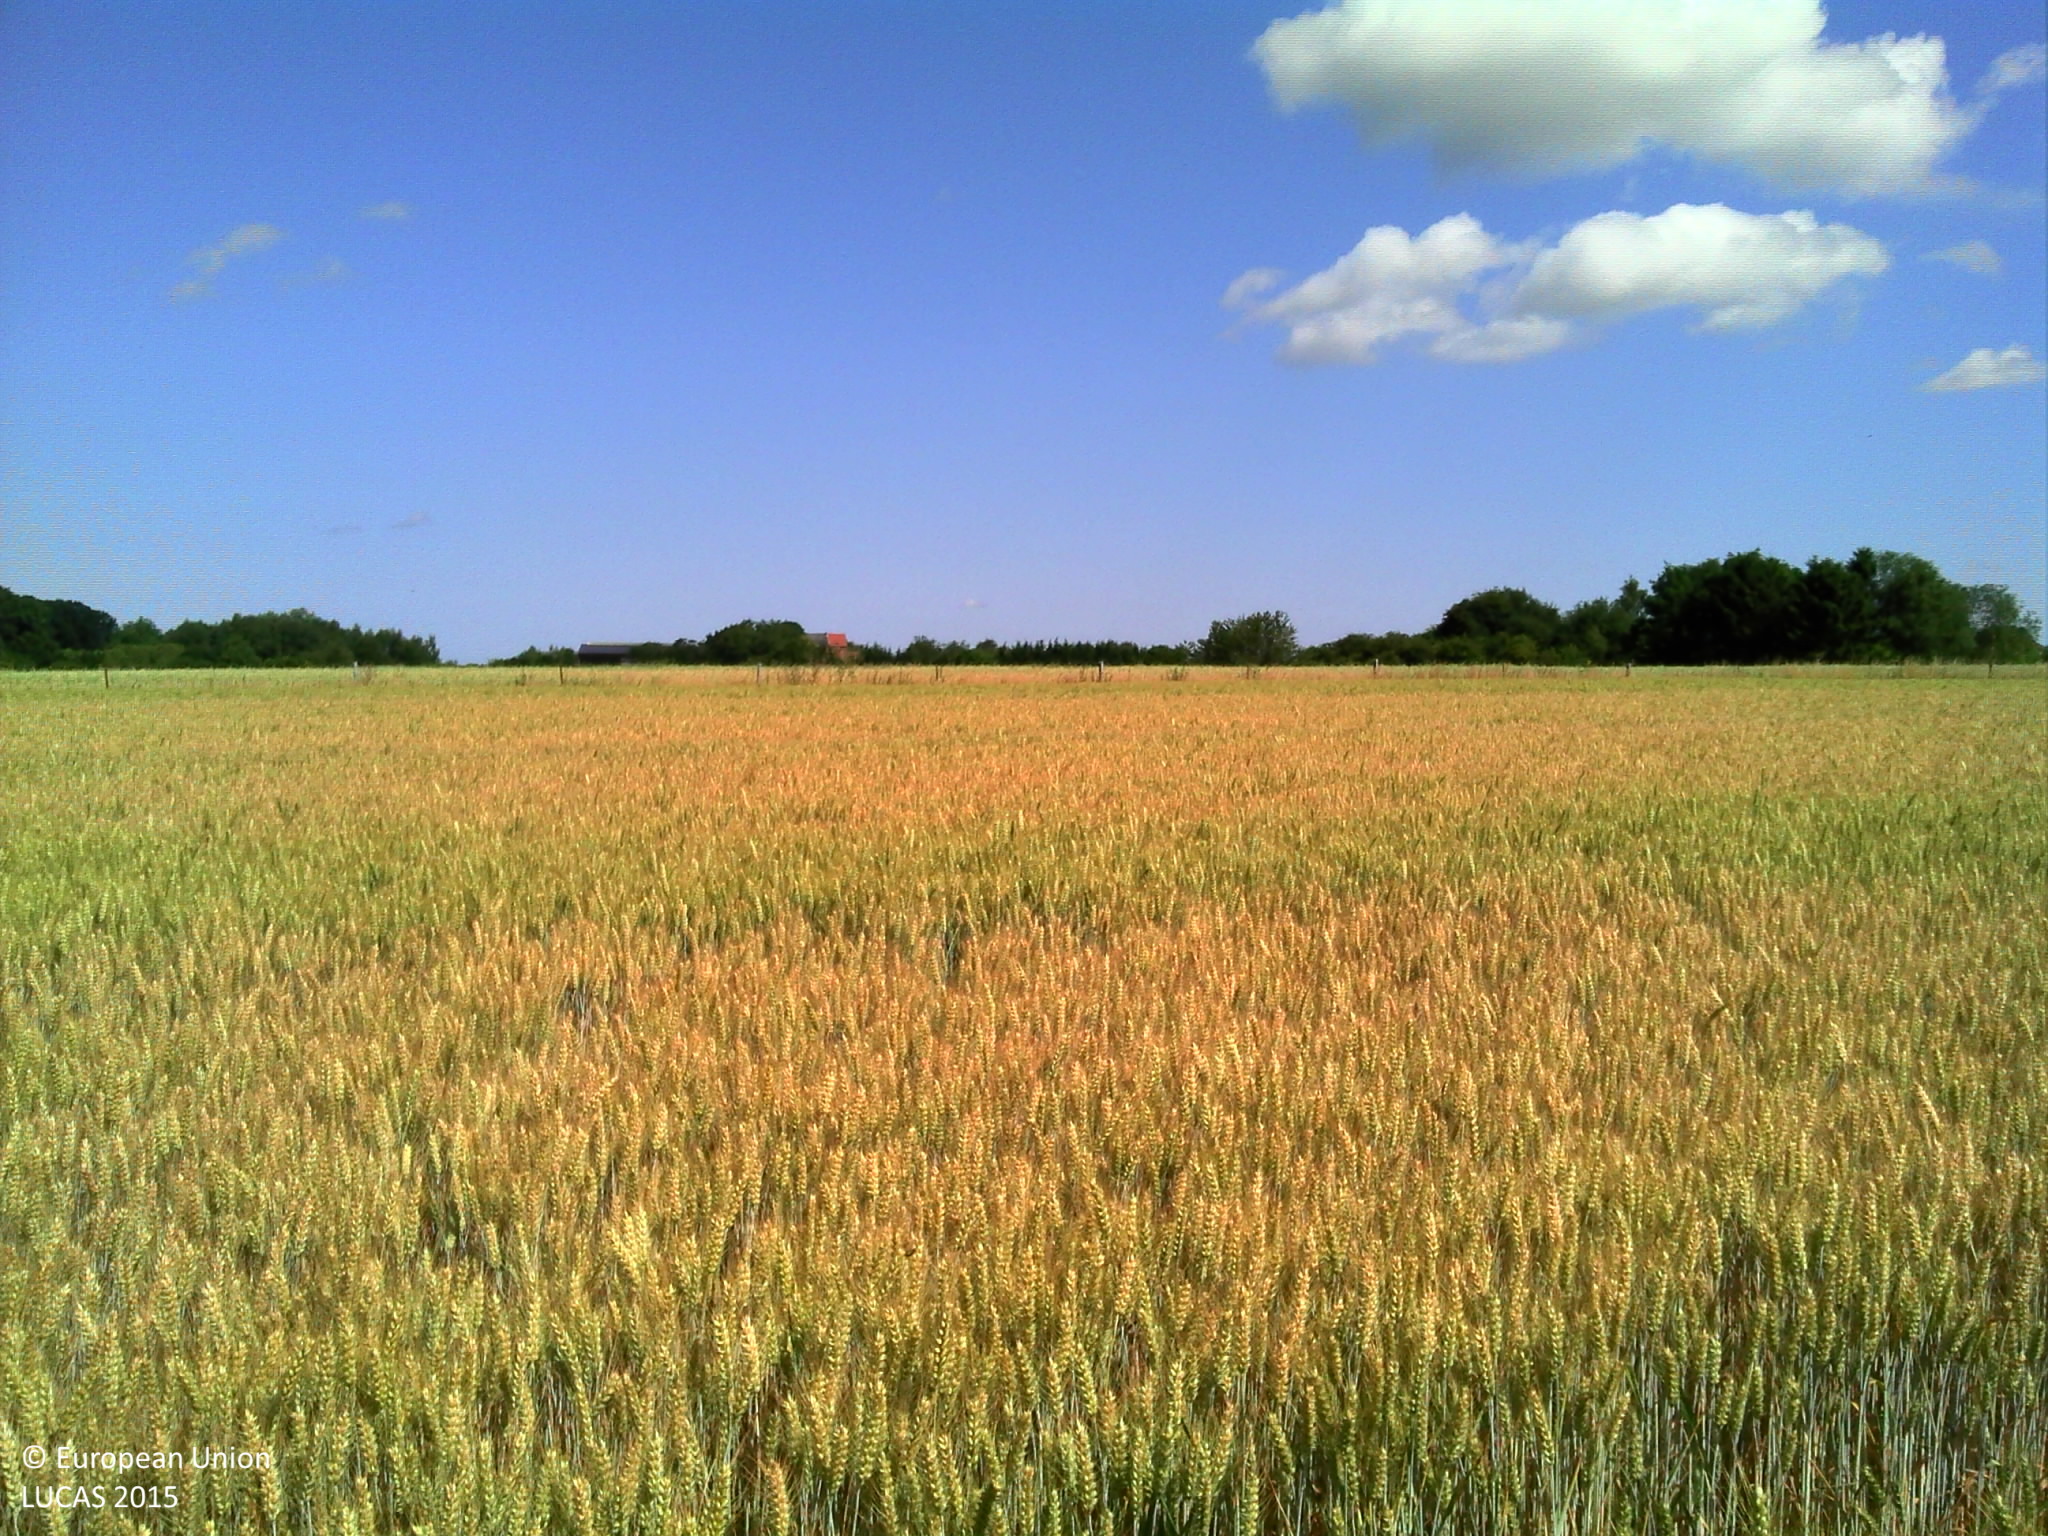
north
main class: Cropland
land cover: Common wheat
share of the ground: > 75 %
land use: Agriculture (excluding fallow land and kitchen gardens)
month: July
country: BE
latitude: 50.2531
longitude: 4.5684
